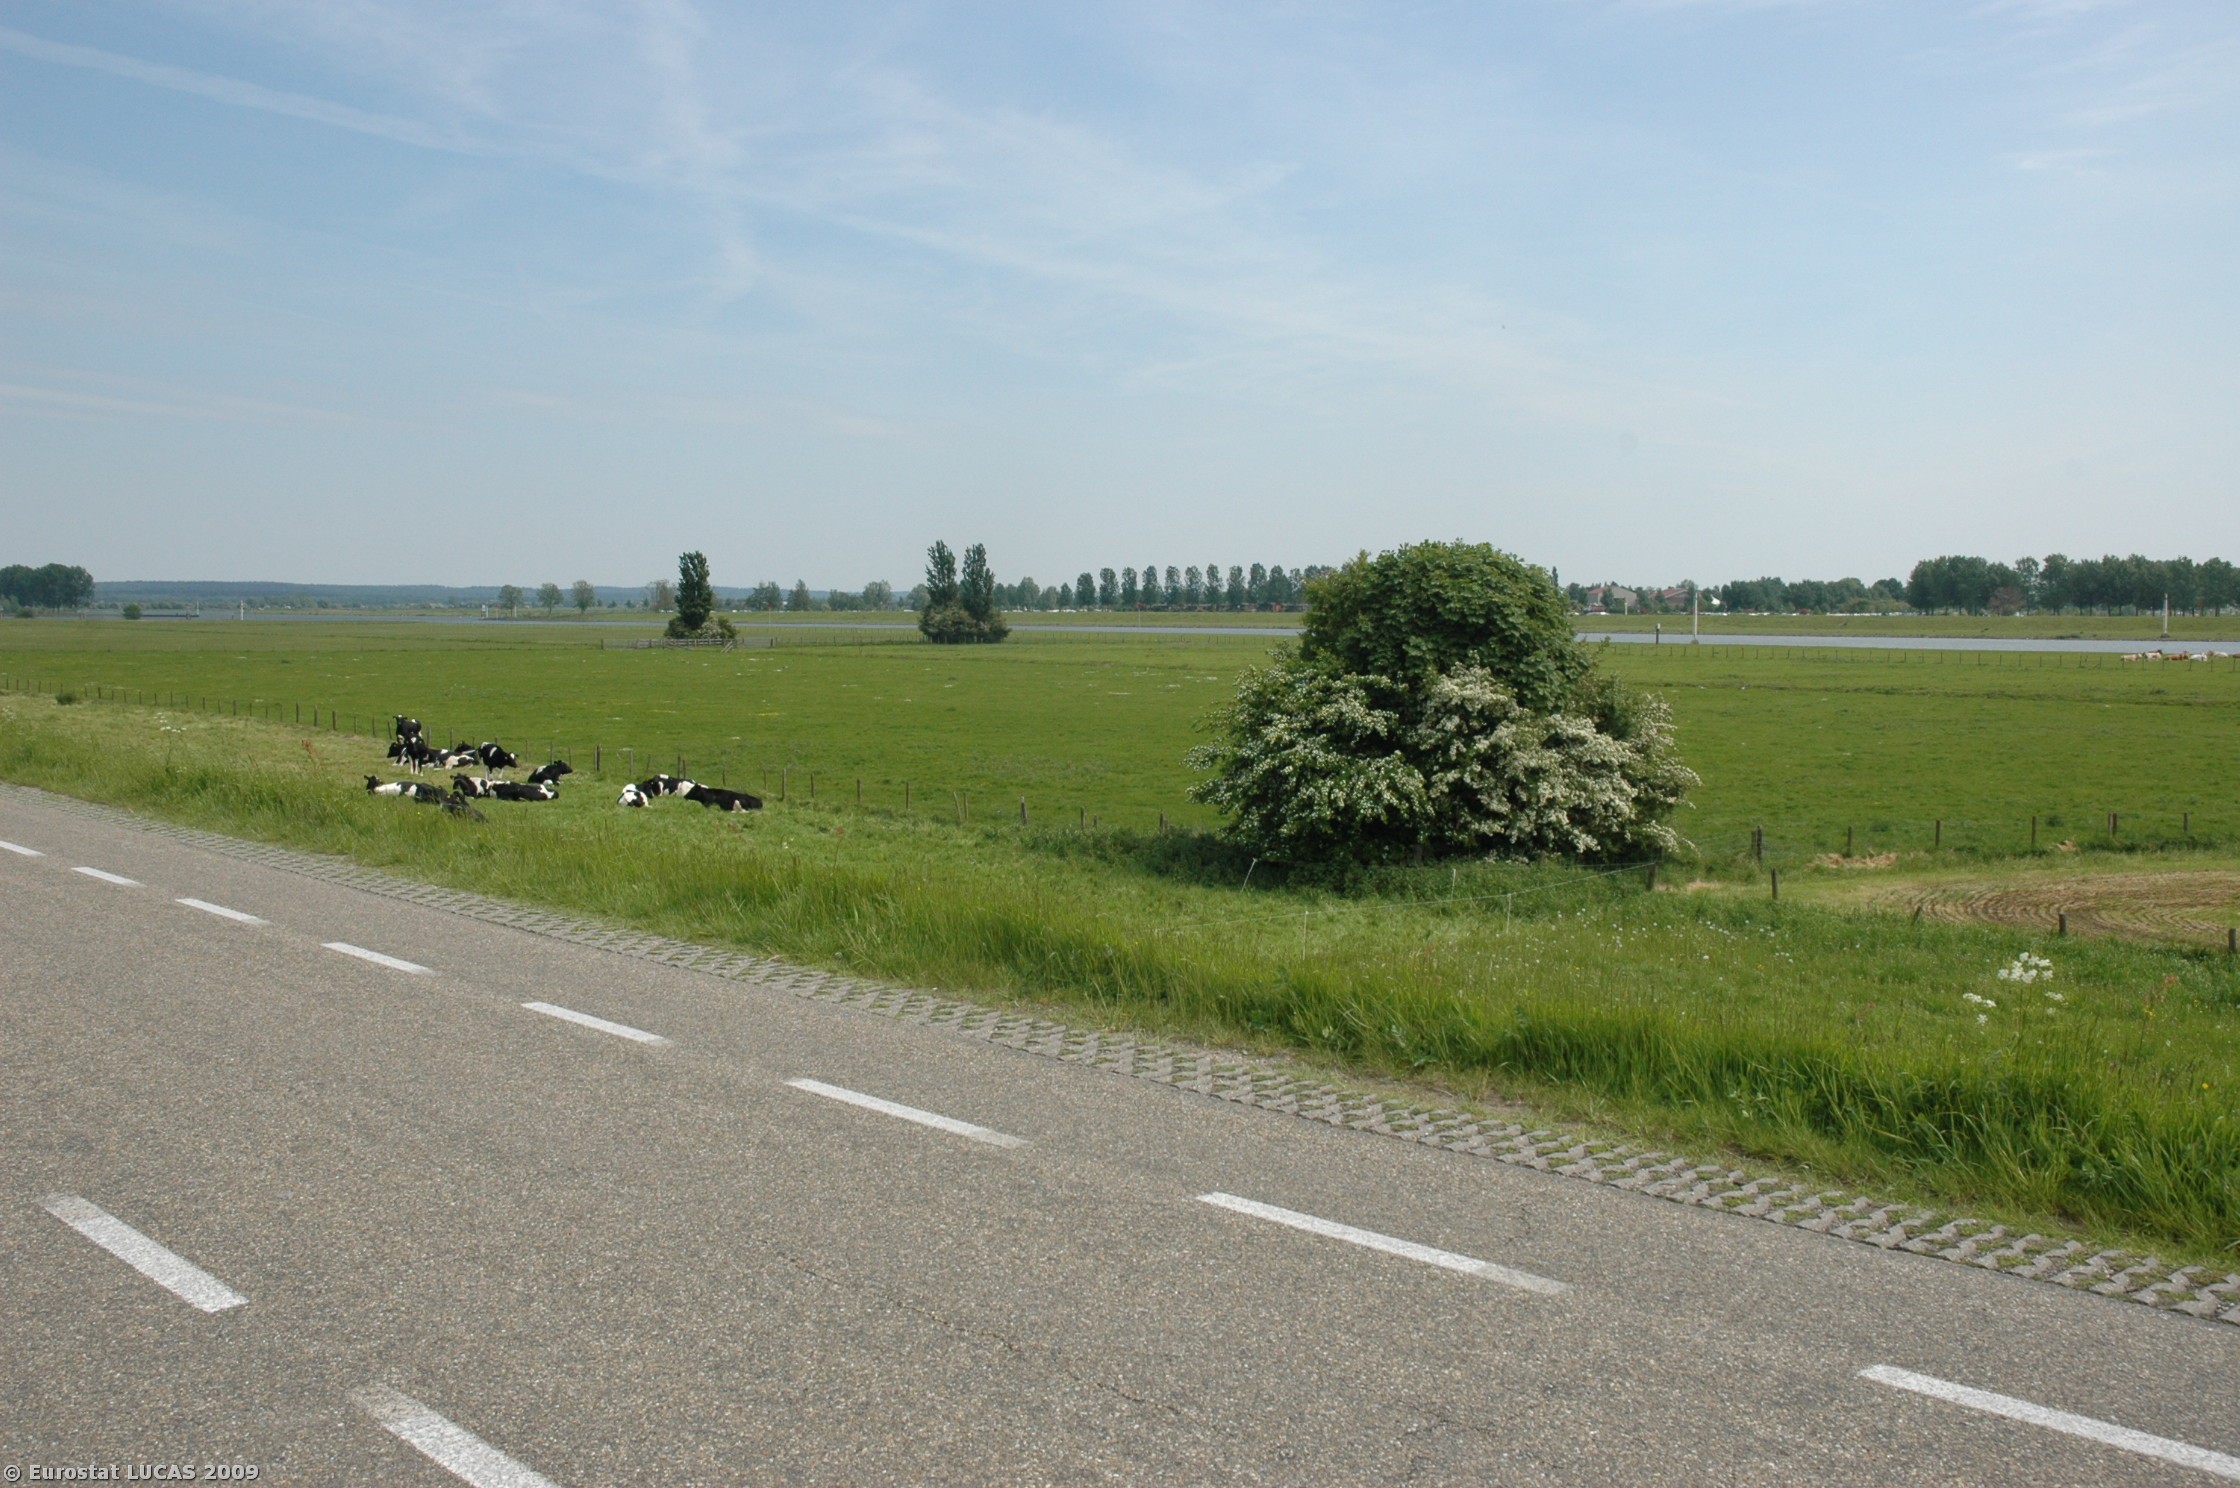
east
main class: Grassland
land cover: Grassland without tree/shrub cover
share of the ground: > 75 %
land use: Agriculture (excluding fallow land and kitchen gardens)
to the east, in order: Grassland without tree/shrub cover; Fences; Ditches and canals; Fences; Grassland without tree/shrub cover; Ditches and canals; Grassland without tree/shrub cover
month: May
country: NL
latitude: 51.9828
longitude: 5.4116
